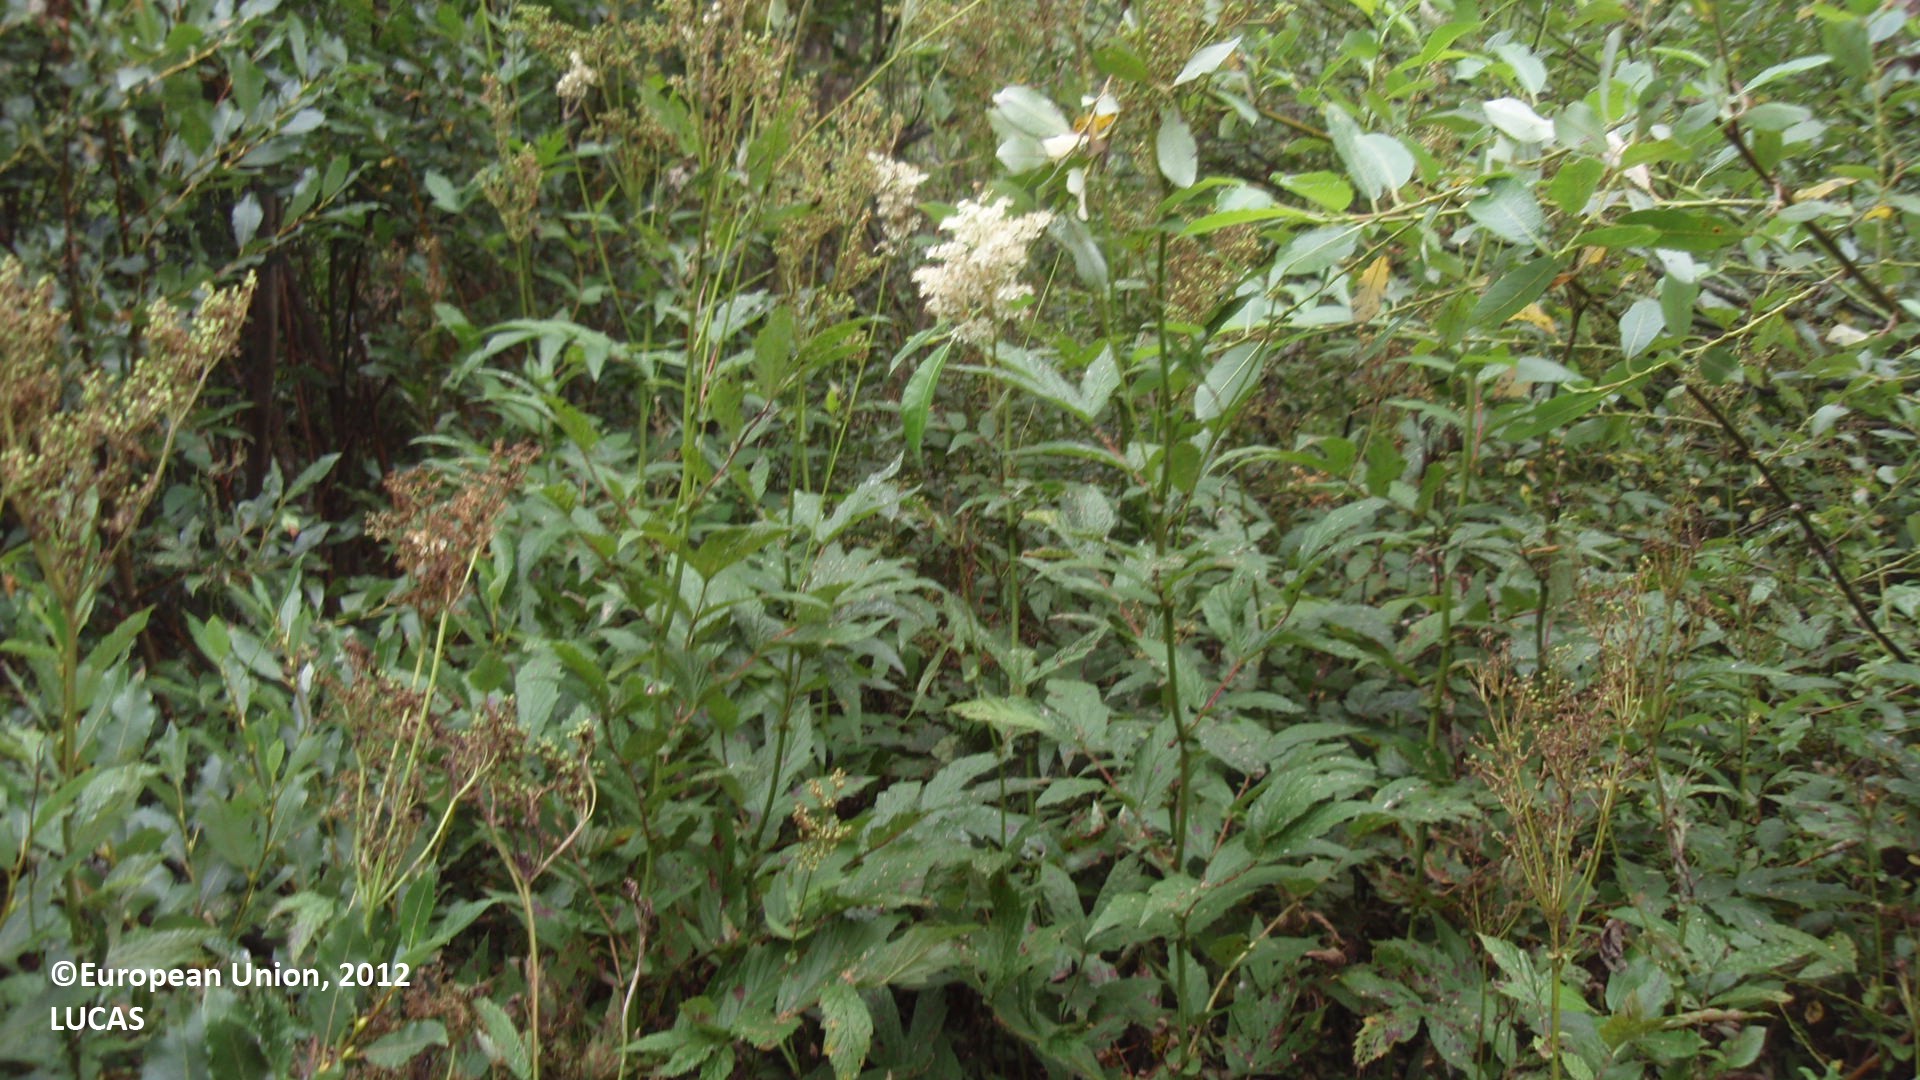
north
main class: Shrubland
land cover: Shrubland with sparse tree cover
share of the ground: > 75 %
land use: Abandoned areas
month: August
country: FI
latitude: 61.2540
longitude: 27.6889
